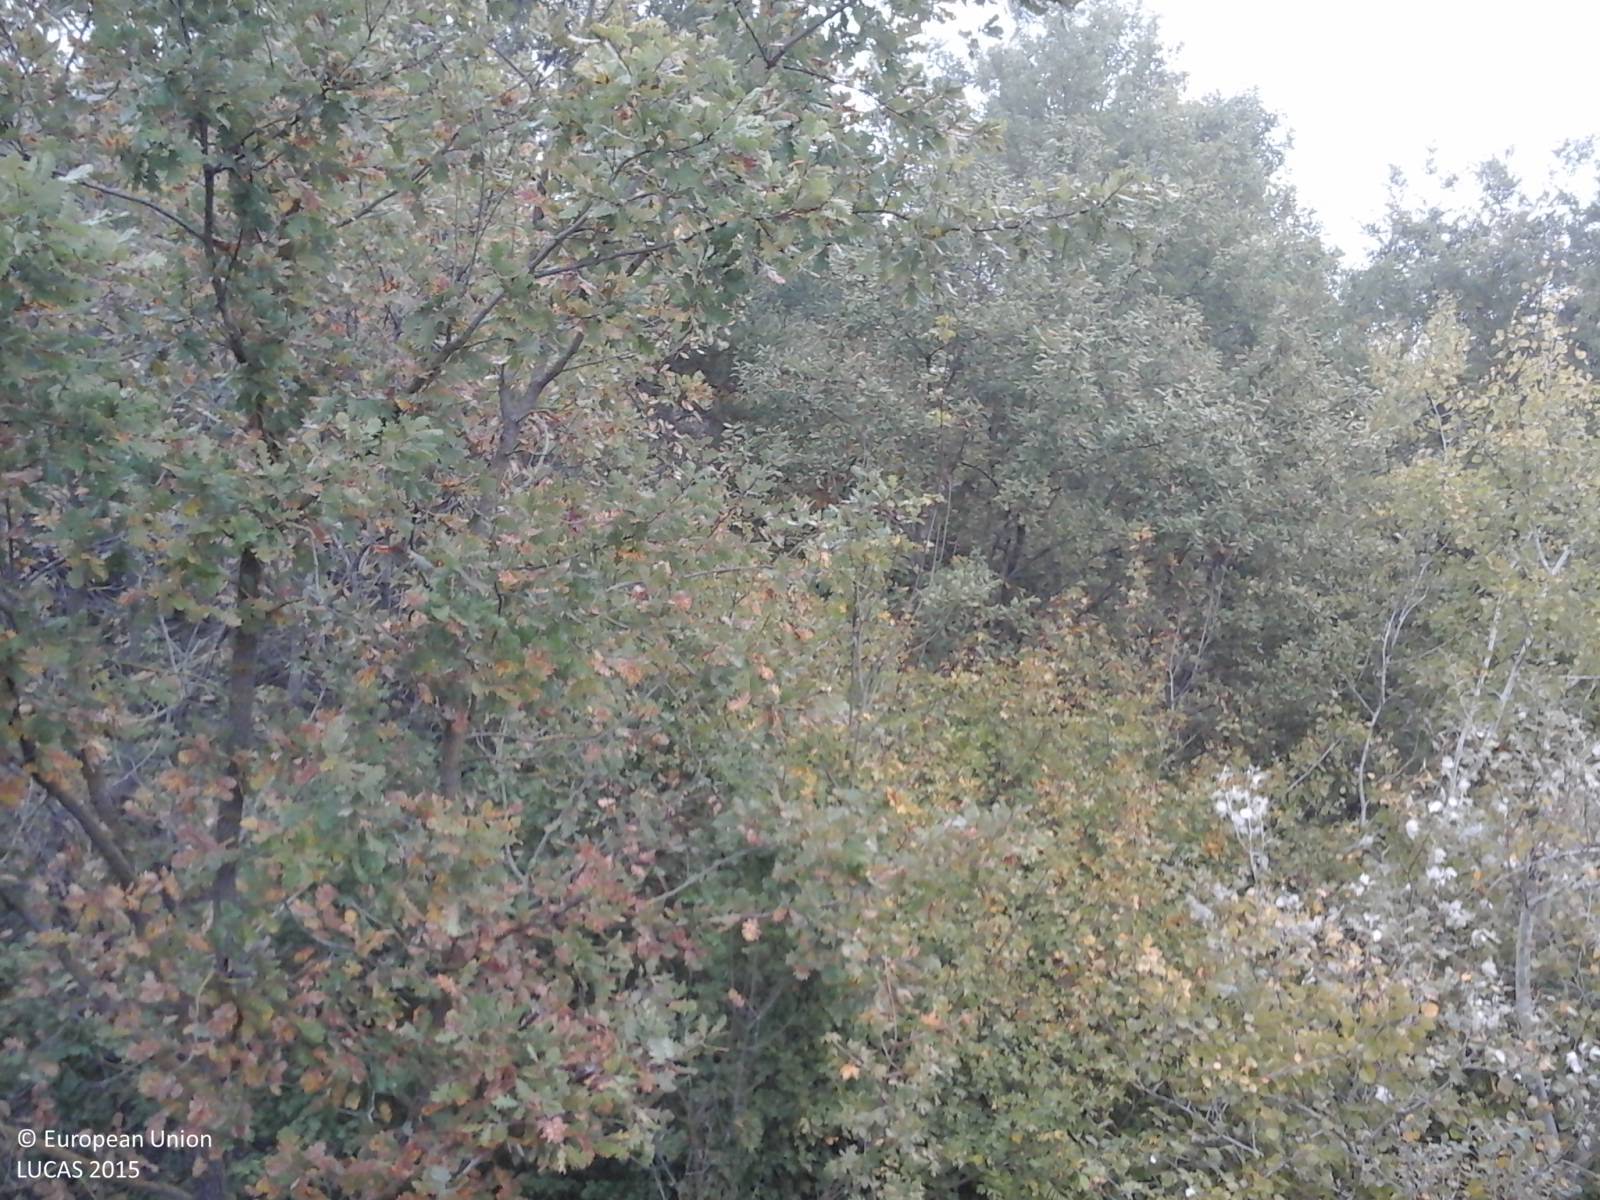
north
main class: Woodland
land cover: Broadleaved woodland
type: thermophilous deciduous forest
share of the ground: > 75 %
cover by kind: broadleaved forest trees 100 %
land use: Forestry
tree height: > 5 m
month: October
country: IT
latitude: 42.7888
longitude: 12.3765
